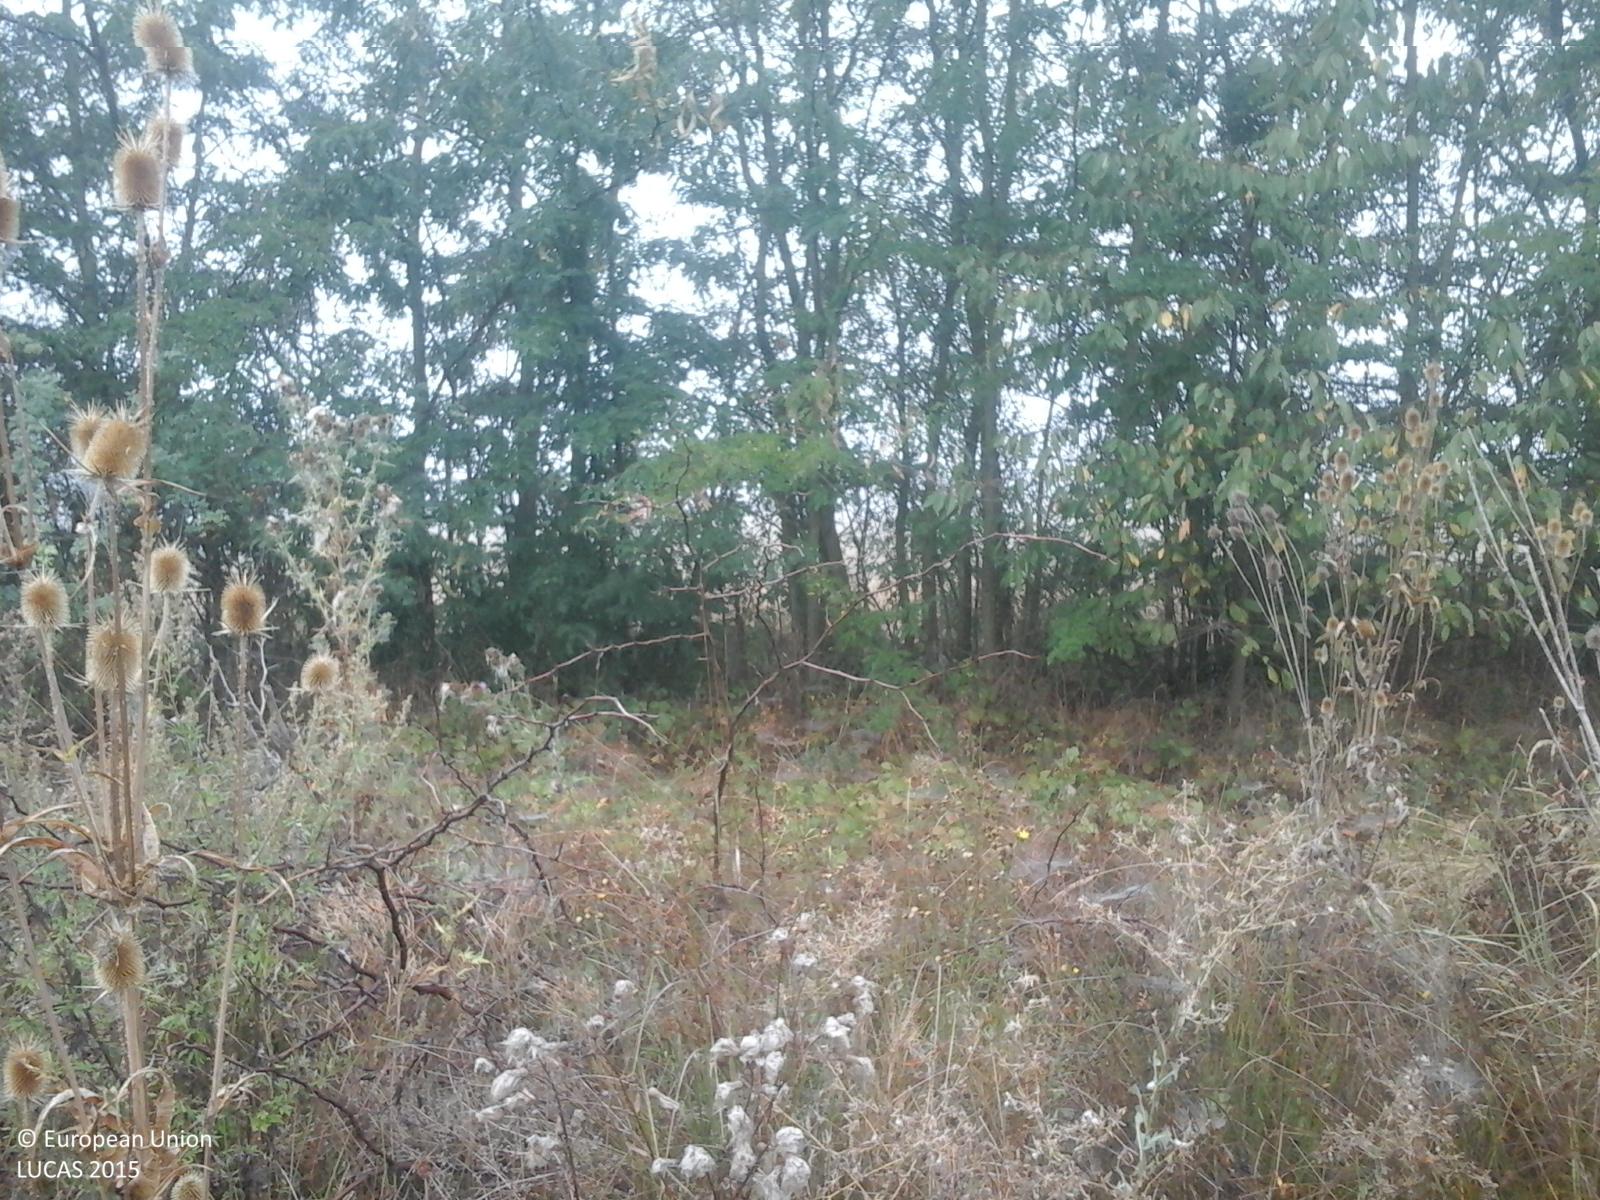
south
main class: Grassland
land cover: Spontaneously vegetated surfaces
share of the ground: > 75 %
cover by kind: herbaceous plants 100 %
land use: Fallow land
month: September
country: RO
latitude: 47.9580
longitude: 23.0176
